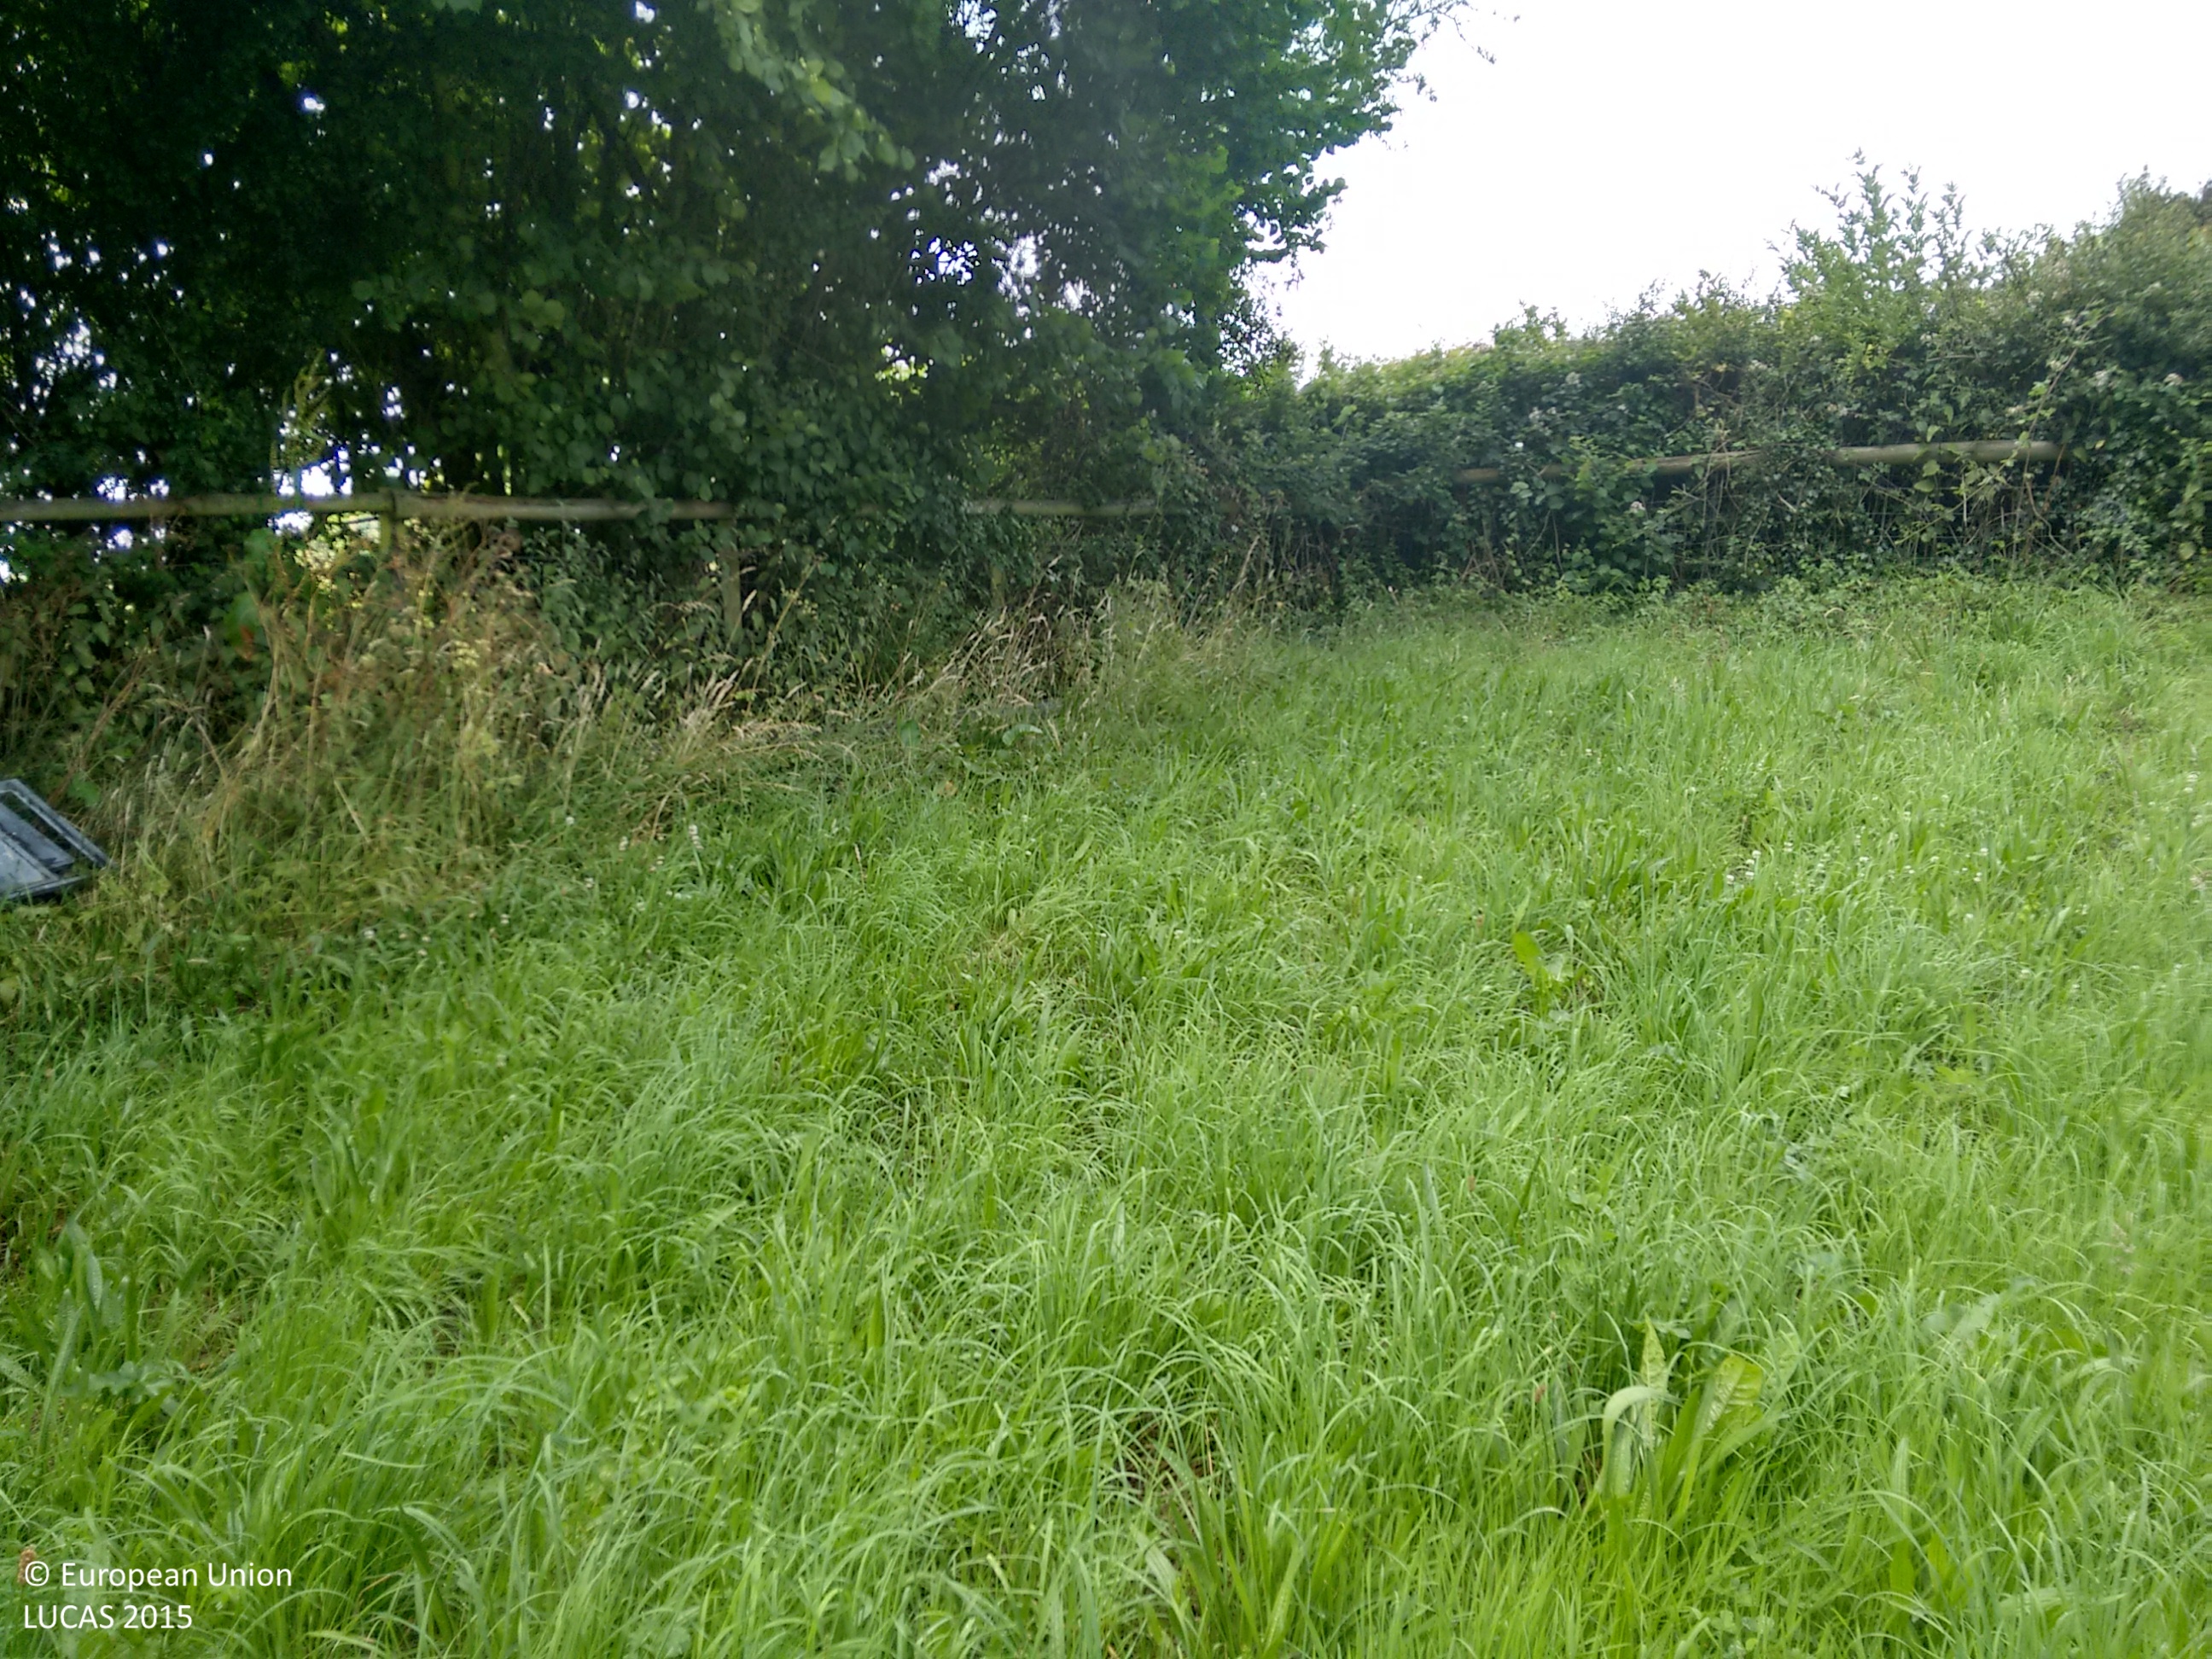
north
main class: Grassland
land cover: Grassland without tree/shrub cover
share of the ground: > 75 %
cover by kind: herbaceous plants 100 %
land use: Agriculture (excluding fallow land and kitchen gardens)
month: July
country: GB
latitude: 51.4192
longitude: -2.3591
